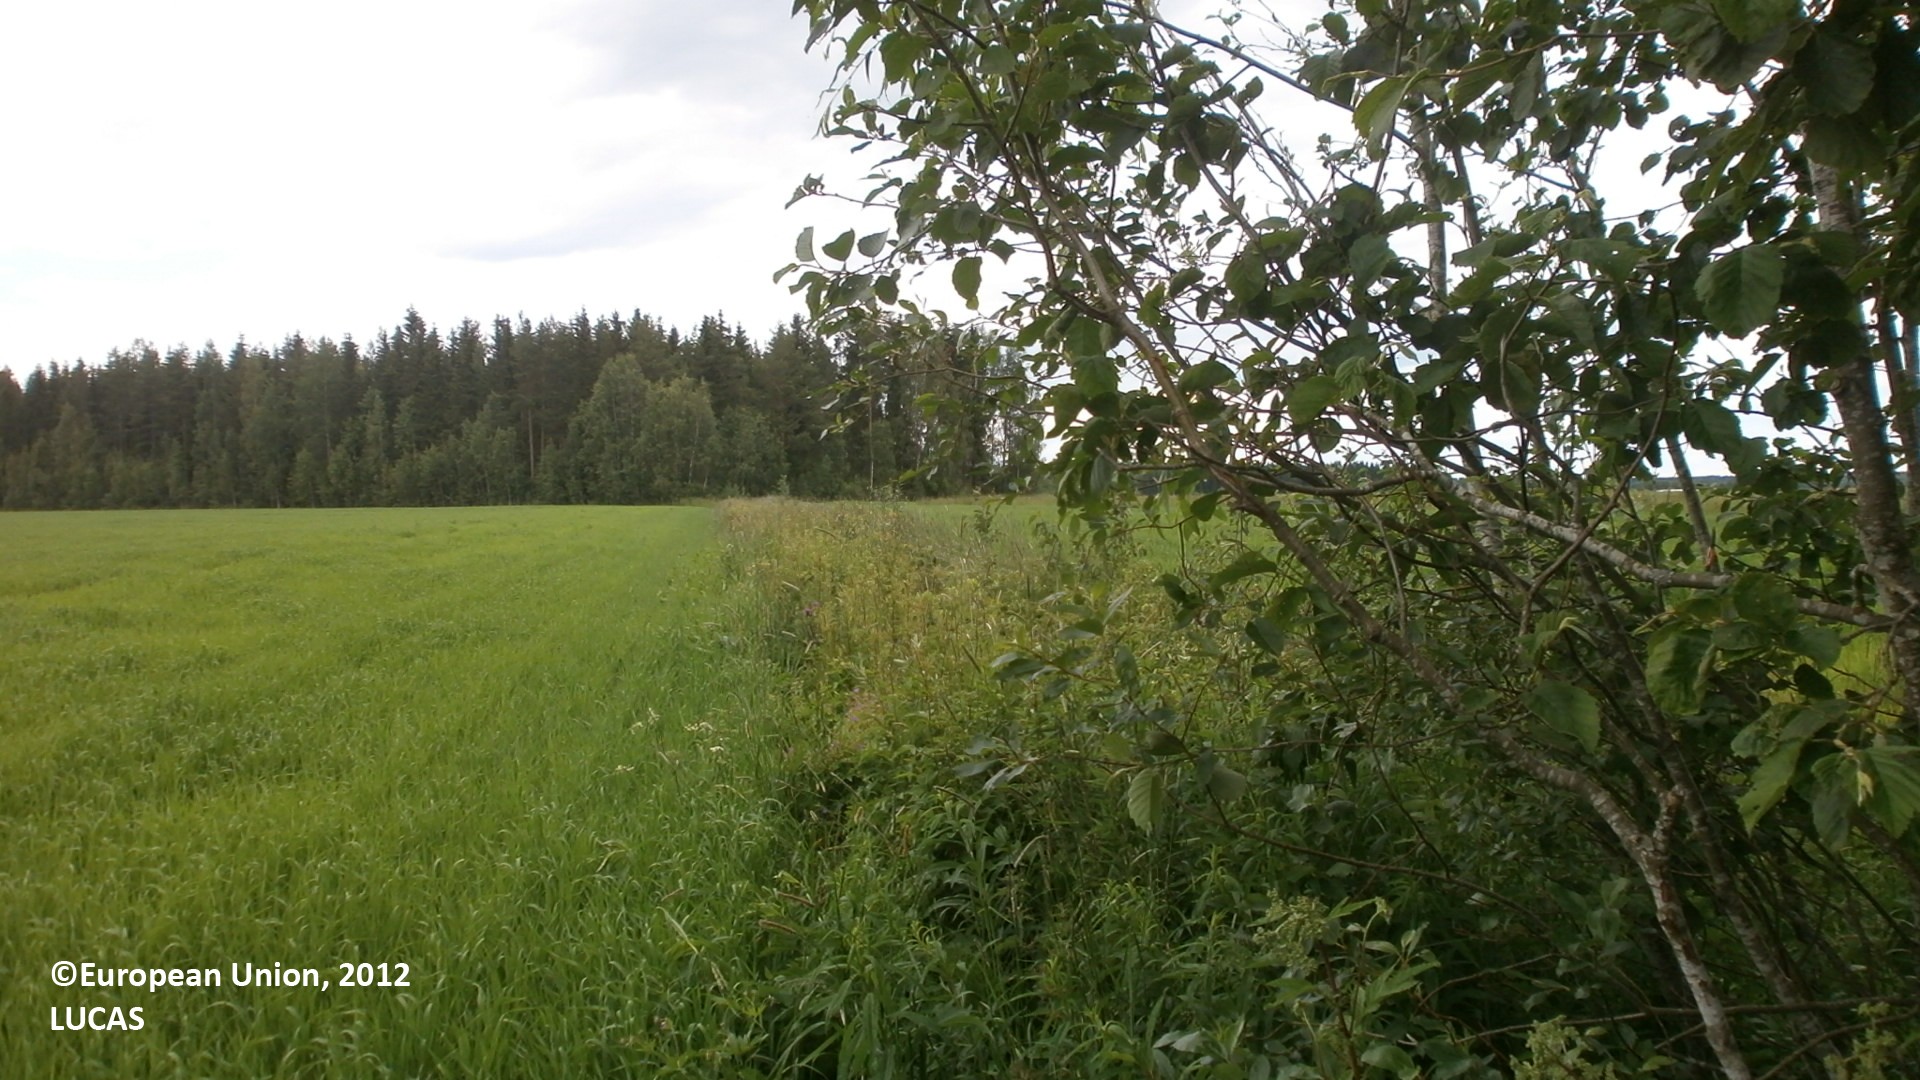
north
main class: Cropland
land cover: Barley
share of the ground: > 75 %
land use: Agriculture (excluding fallow land and kitchen gardens)
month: July
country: FI
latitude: 63.9821
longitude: 24.7297
